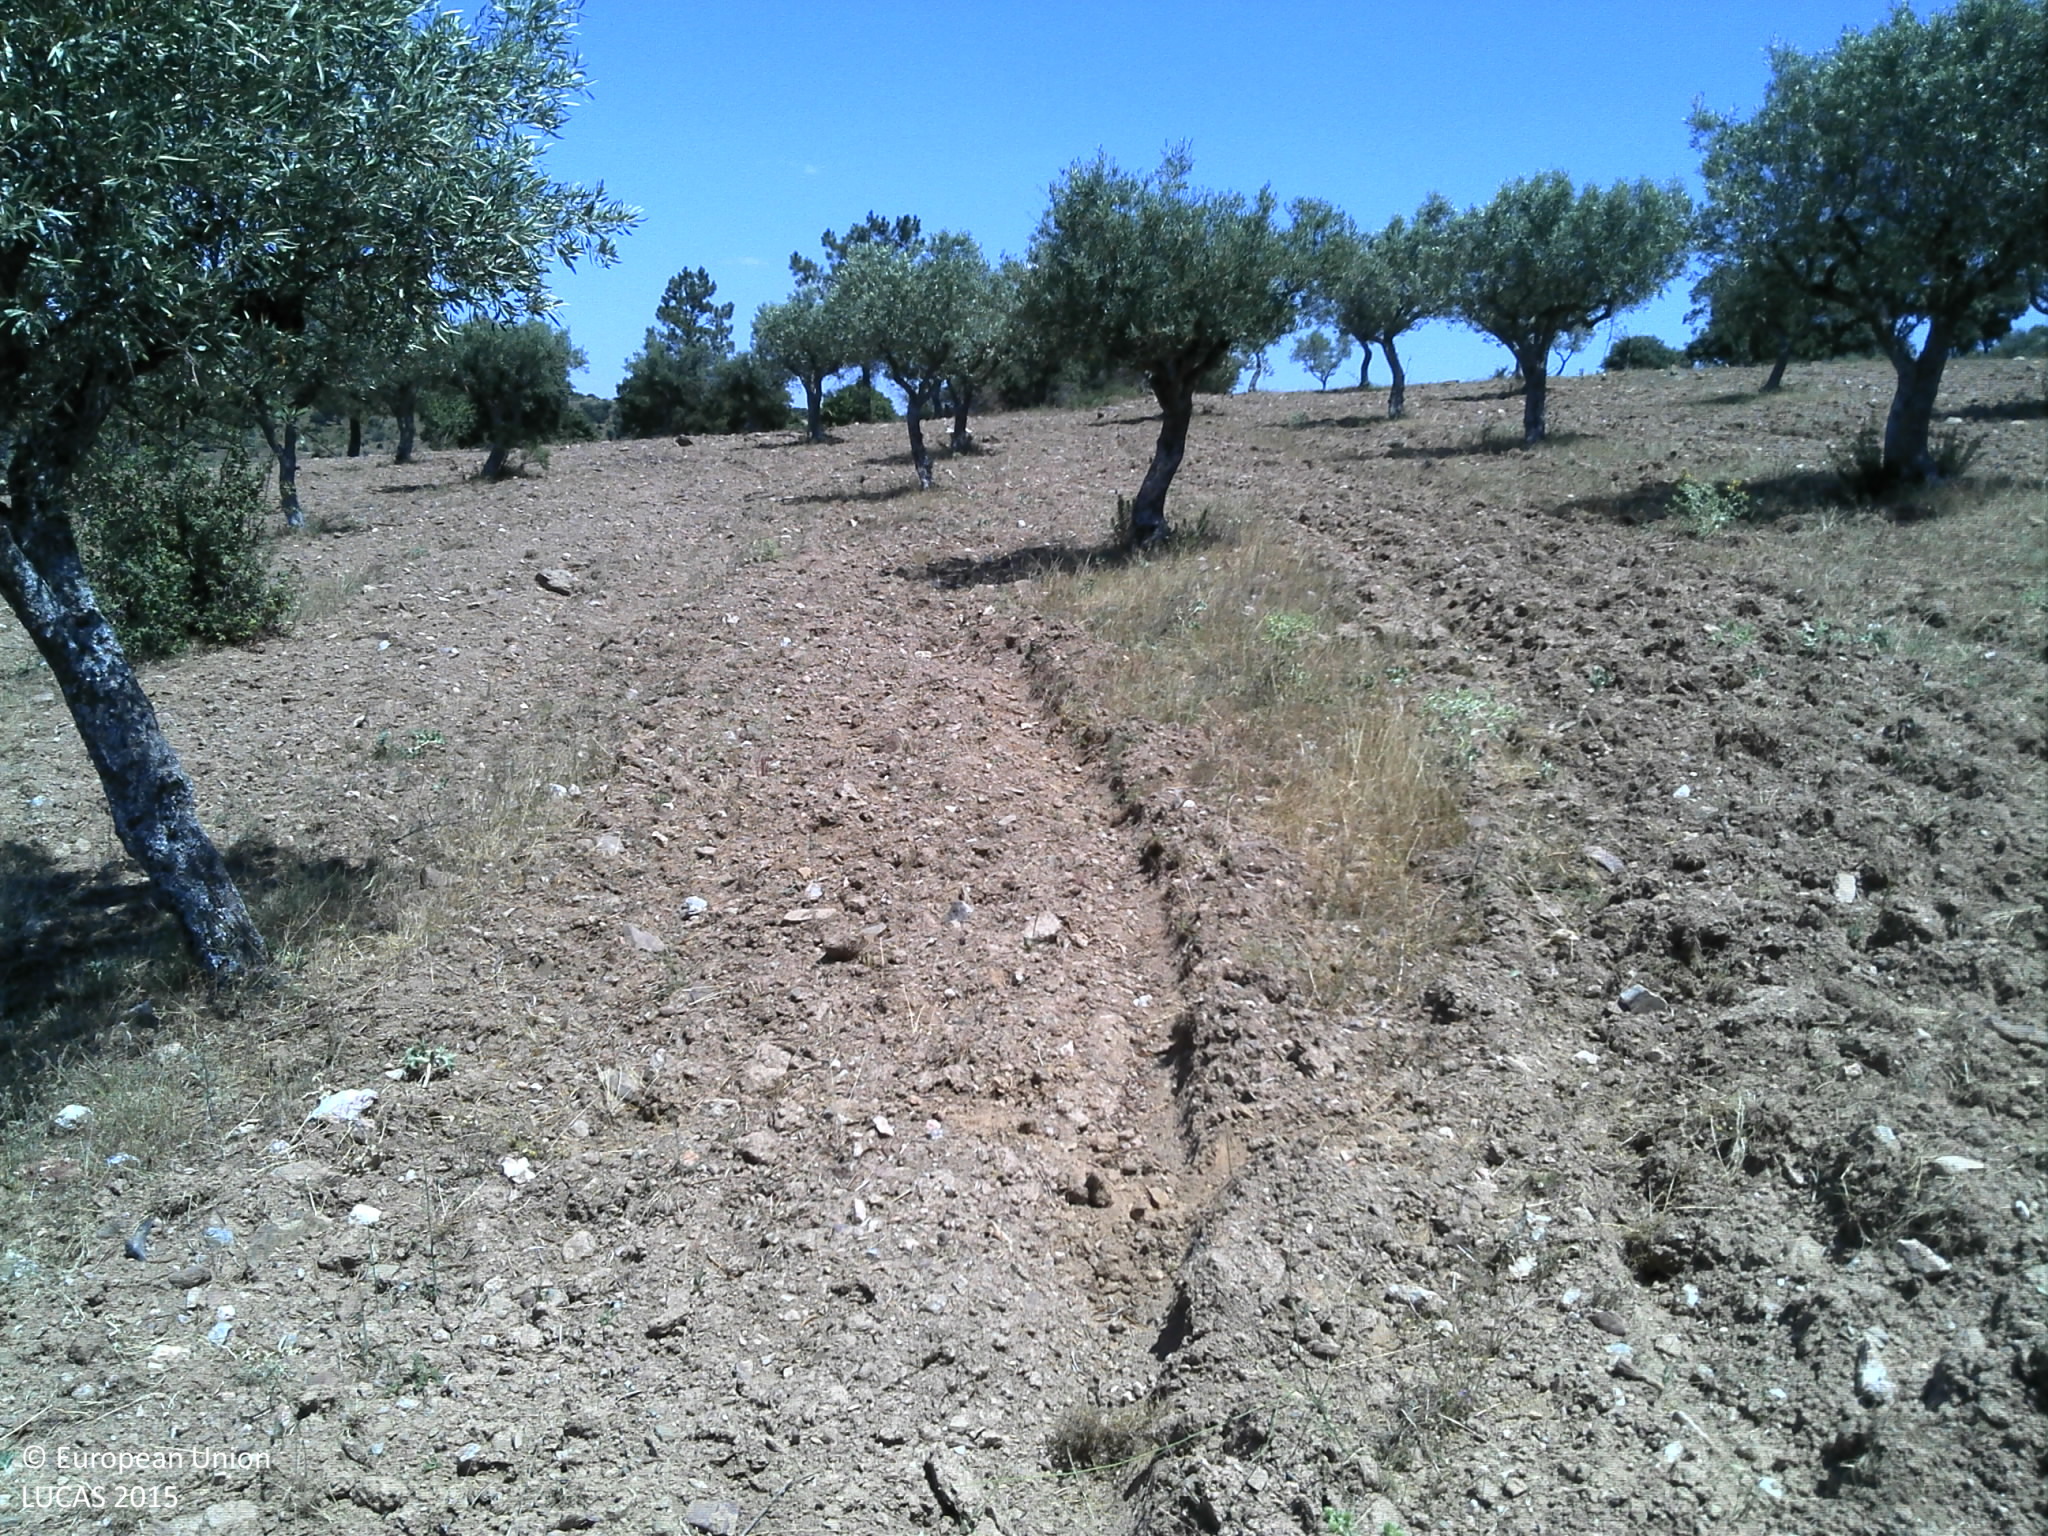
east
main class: Cropland
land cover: Olive groves
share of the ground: 10 - 25 %
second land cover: Other bare soil
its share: > 75 %
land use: Agriculture (excluding fallow land and kitchen gardens)
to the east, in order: Olive groves; Other bare soil; Broadleaved woodland; Fences; Broadleaved woodland
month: June
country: PT
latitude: 40.8395
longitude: -6.9803
